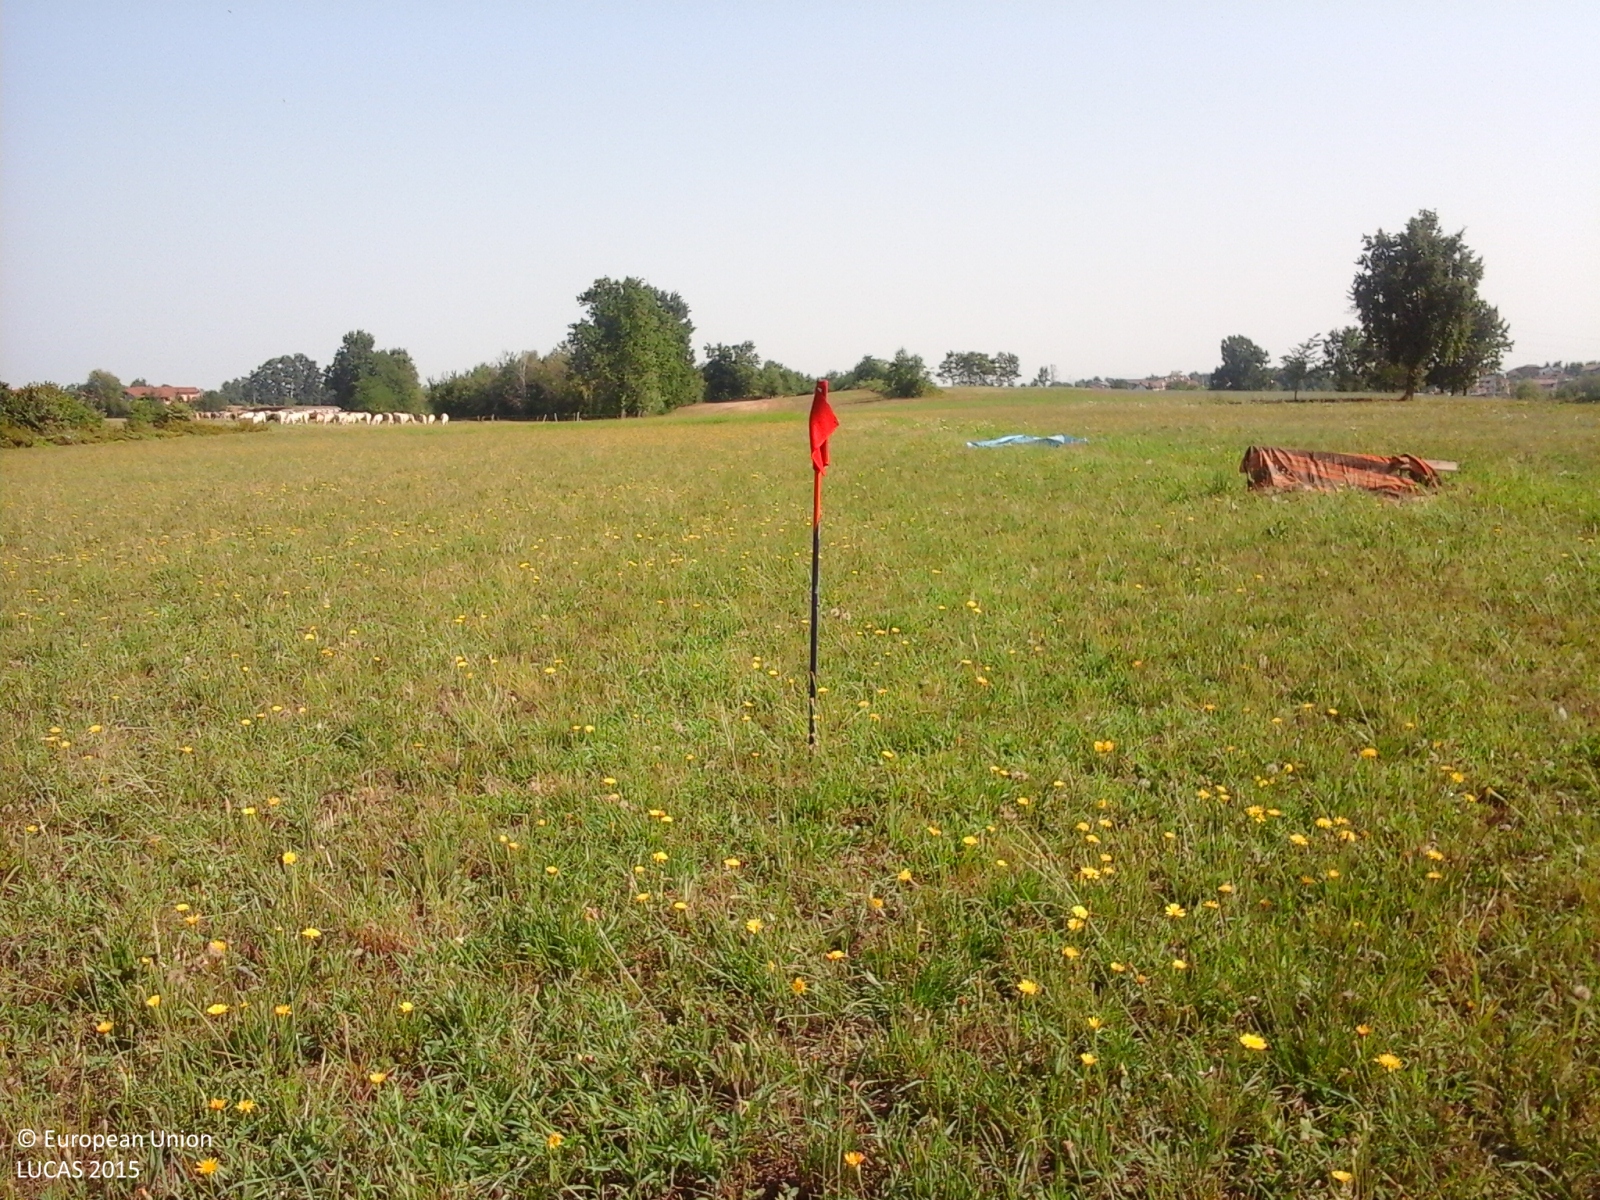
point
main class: Grassland
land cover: Grassland without tree/shrub cover
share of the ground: > 75 %
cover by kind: herbaceous plants 100 %
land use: Agriculture (excluding fallow land and kitchen gardens)
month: August
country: IT
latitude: 44.3991
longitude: 7.7824
